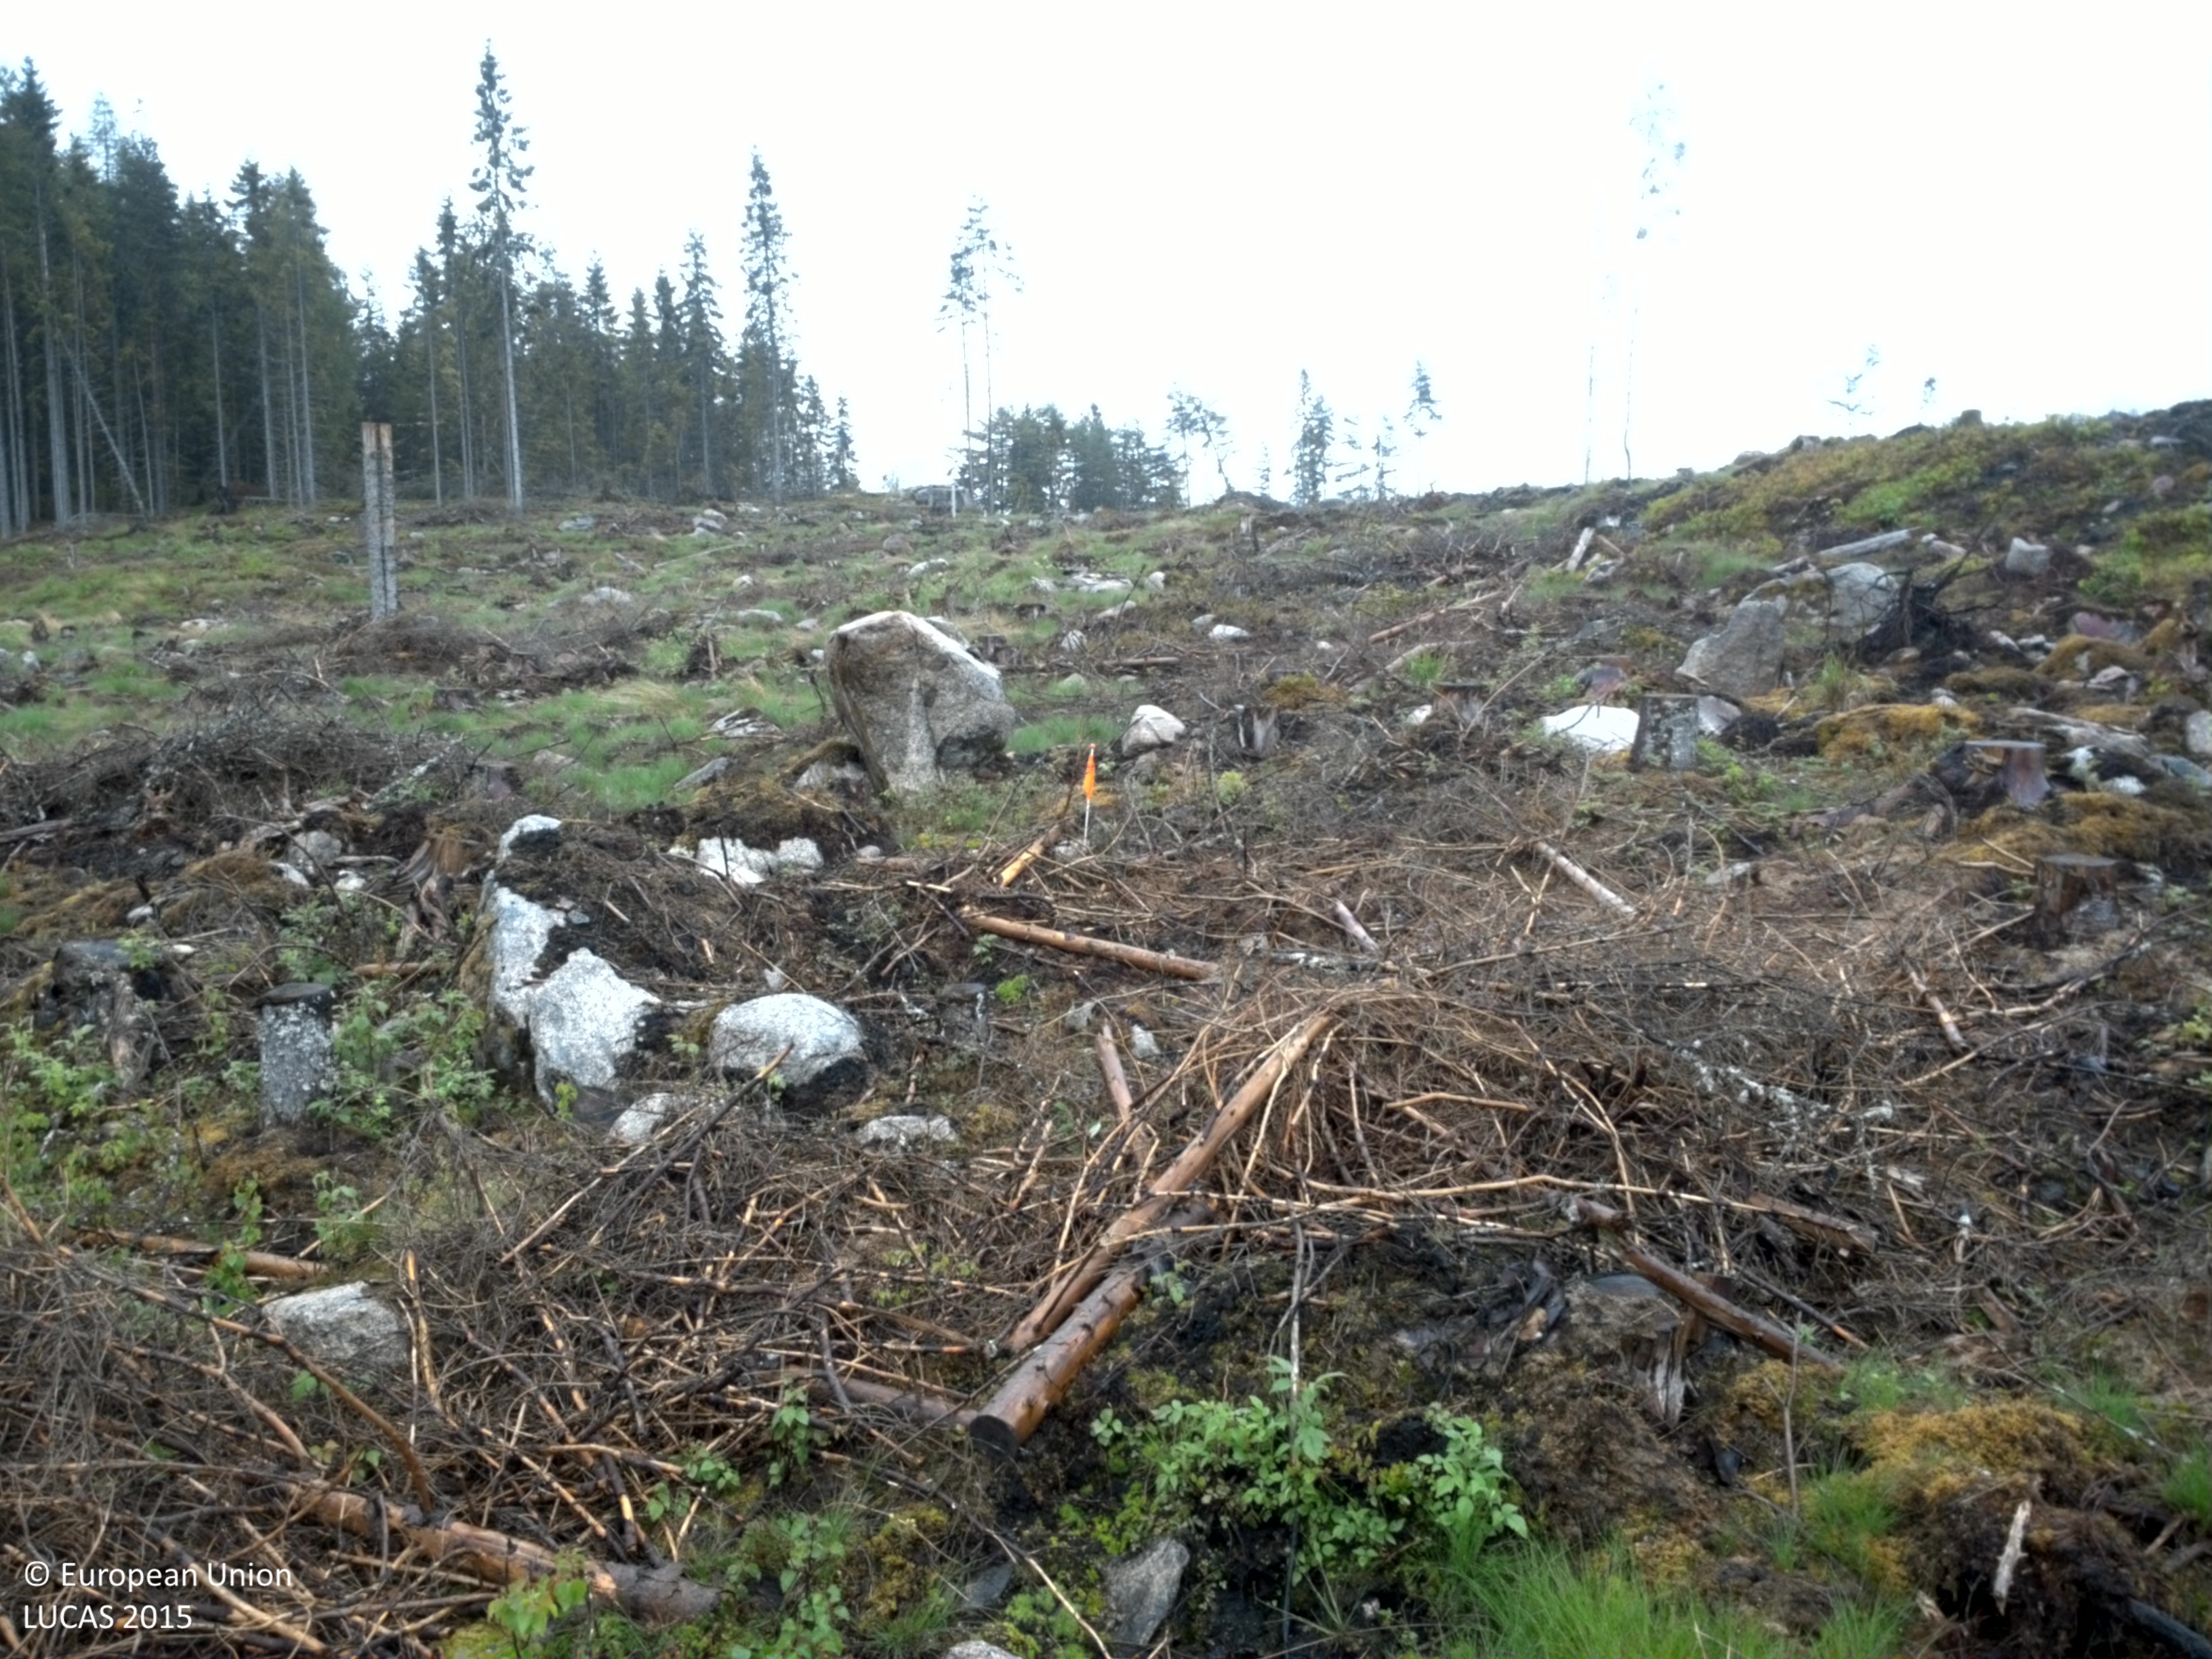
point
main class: Woodland
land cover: Broadleaved woodland
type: boreal forest
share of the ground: 10 - 25 %
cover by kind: shrubs 35 %, herbaceous plants 35 %, broadleaved forest trees 10 %, lichens and mosses 10 %, consolidated bare surface 10 %
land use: Forestry
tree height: < 5 m
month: May
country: SE
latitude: 59.4521
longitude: 14.1718
